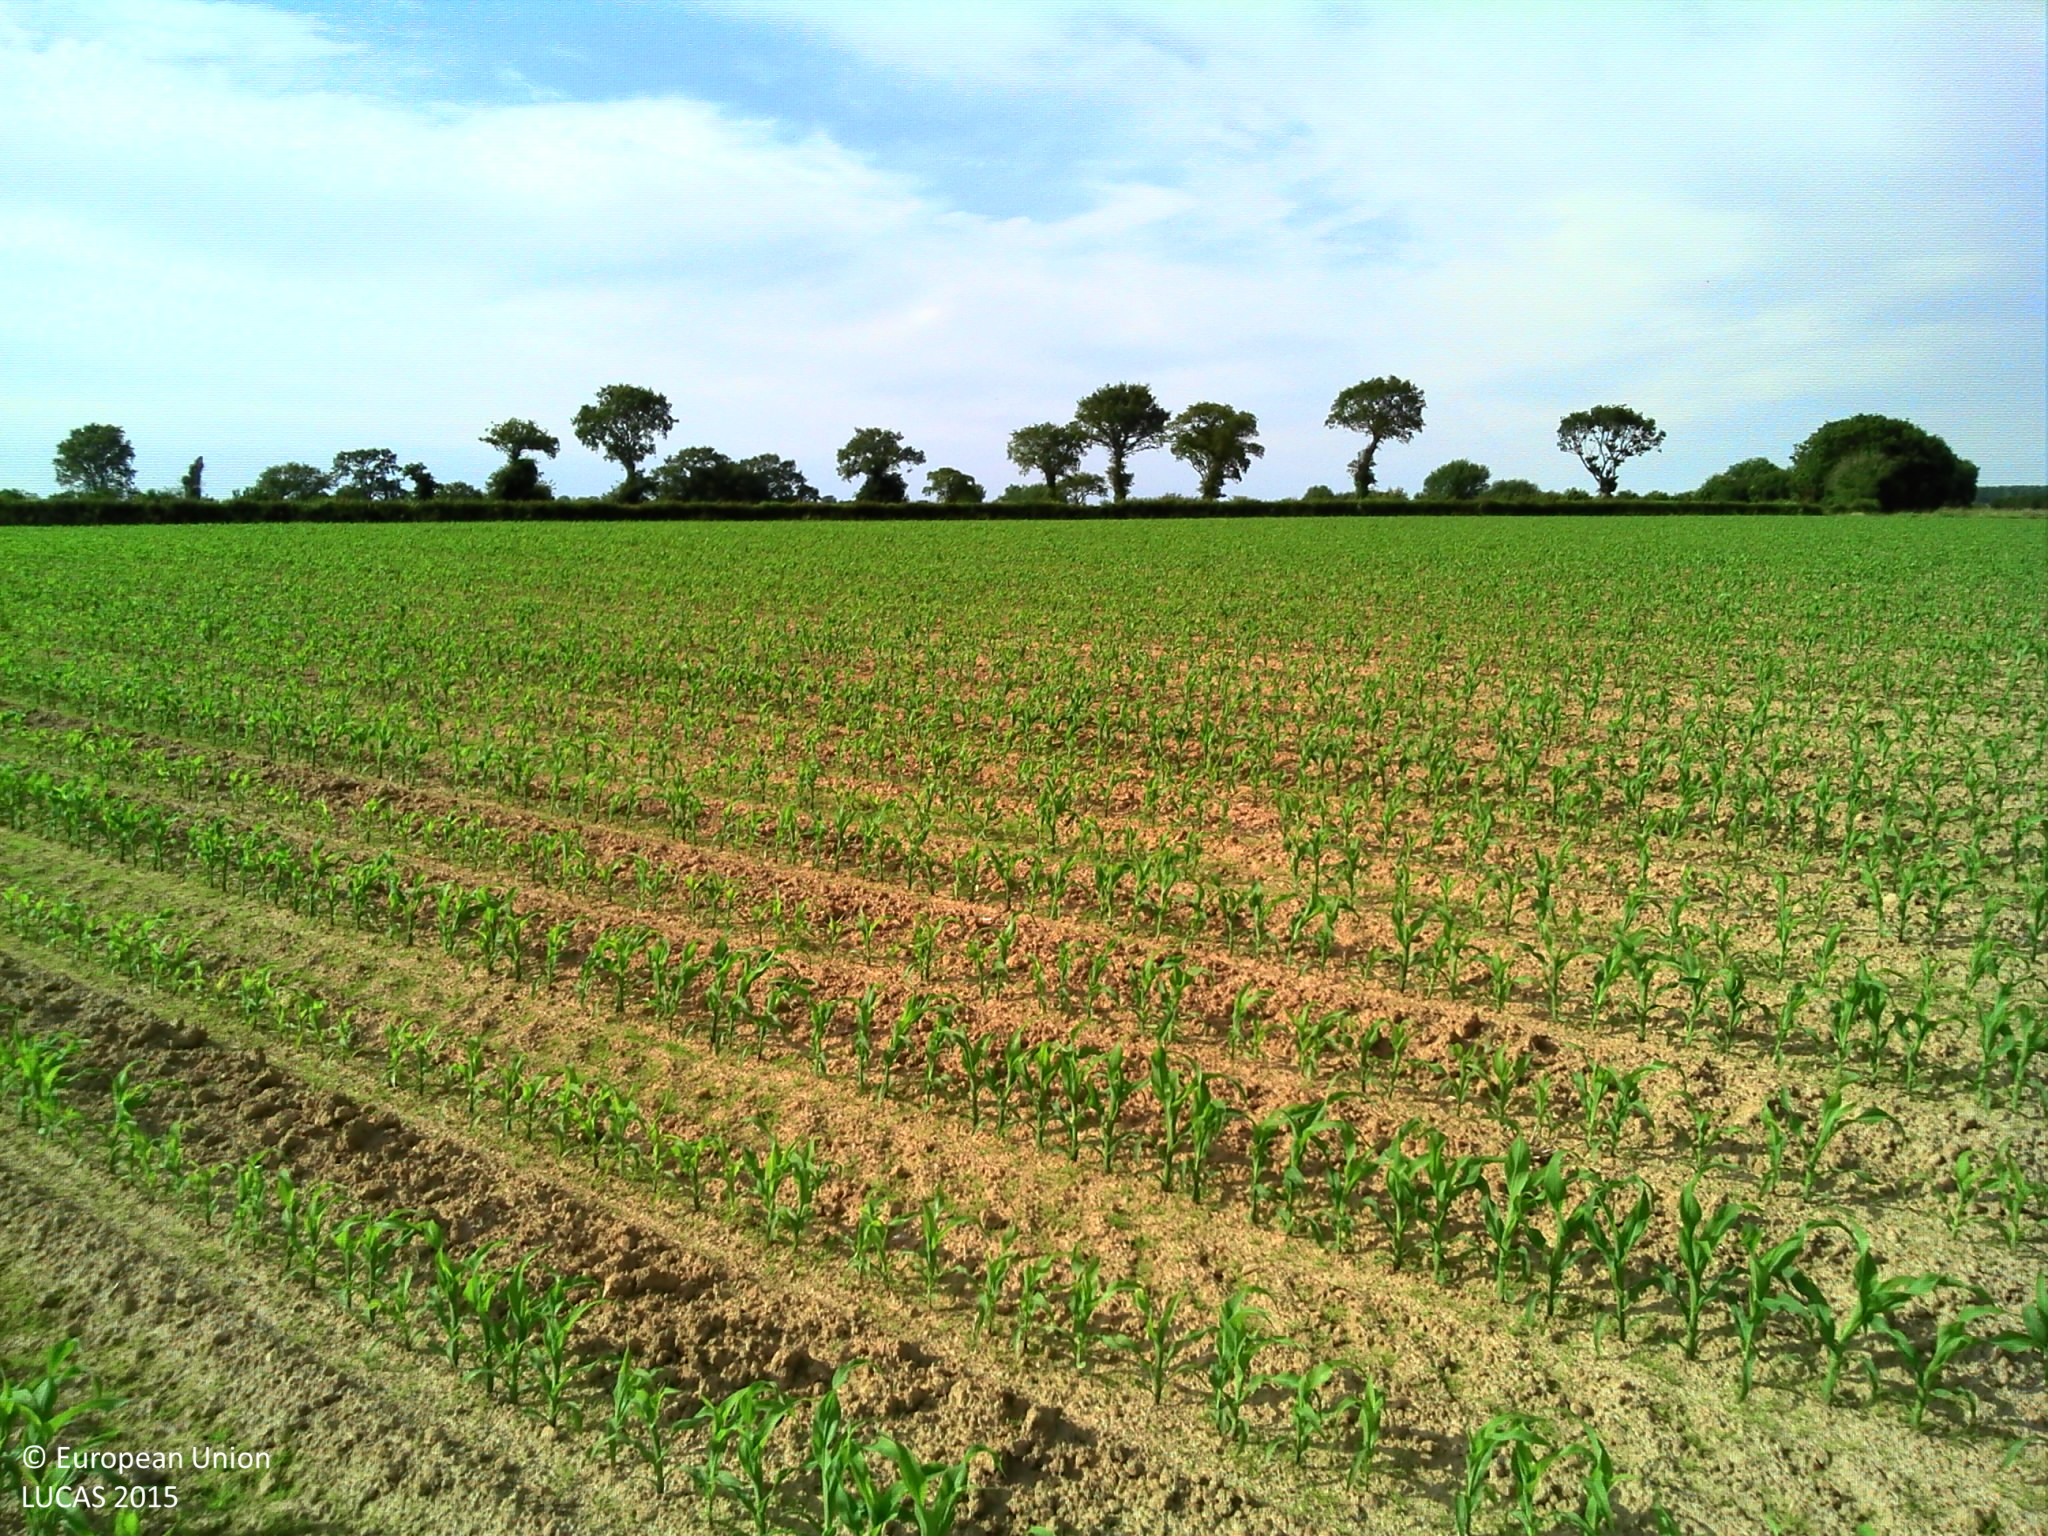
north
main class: Cropland
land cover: Maize
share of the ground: 10 - 25 %
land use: Agriculture (excluding fallow land and kitchen gardens)
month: June
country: FR
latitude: 49.2378
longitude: -1.4897
